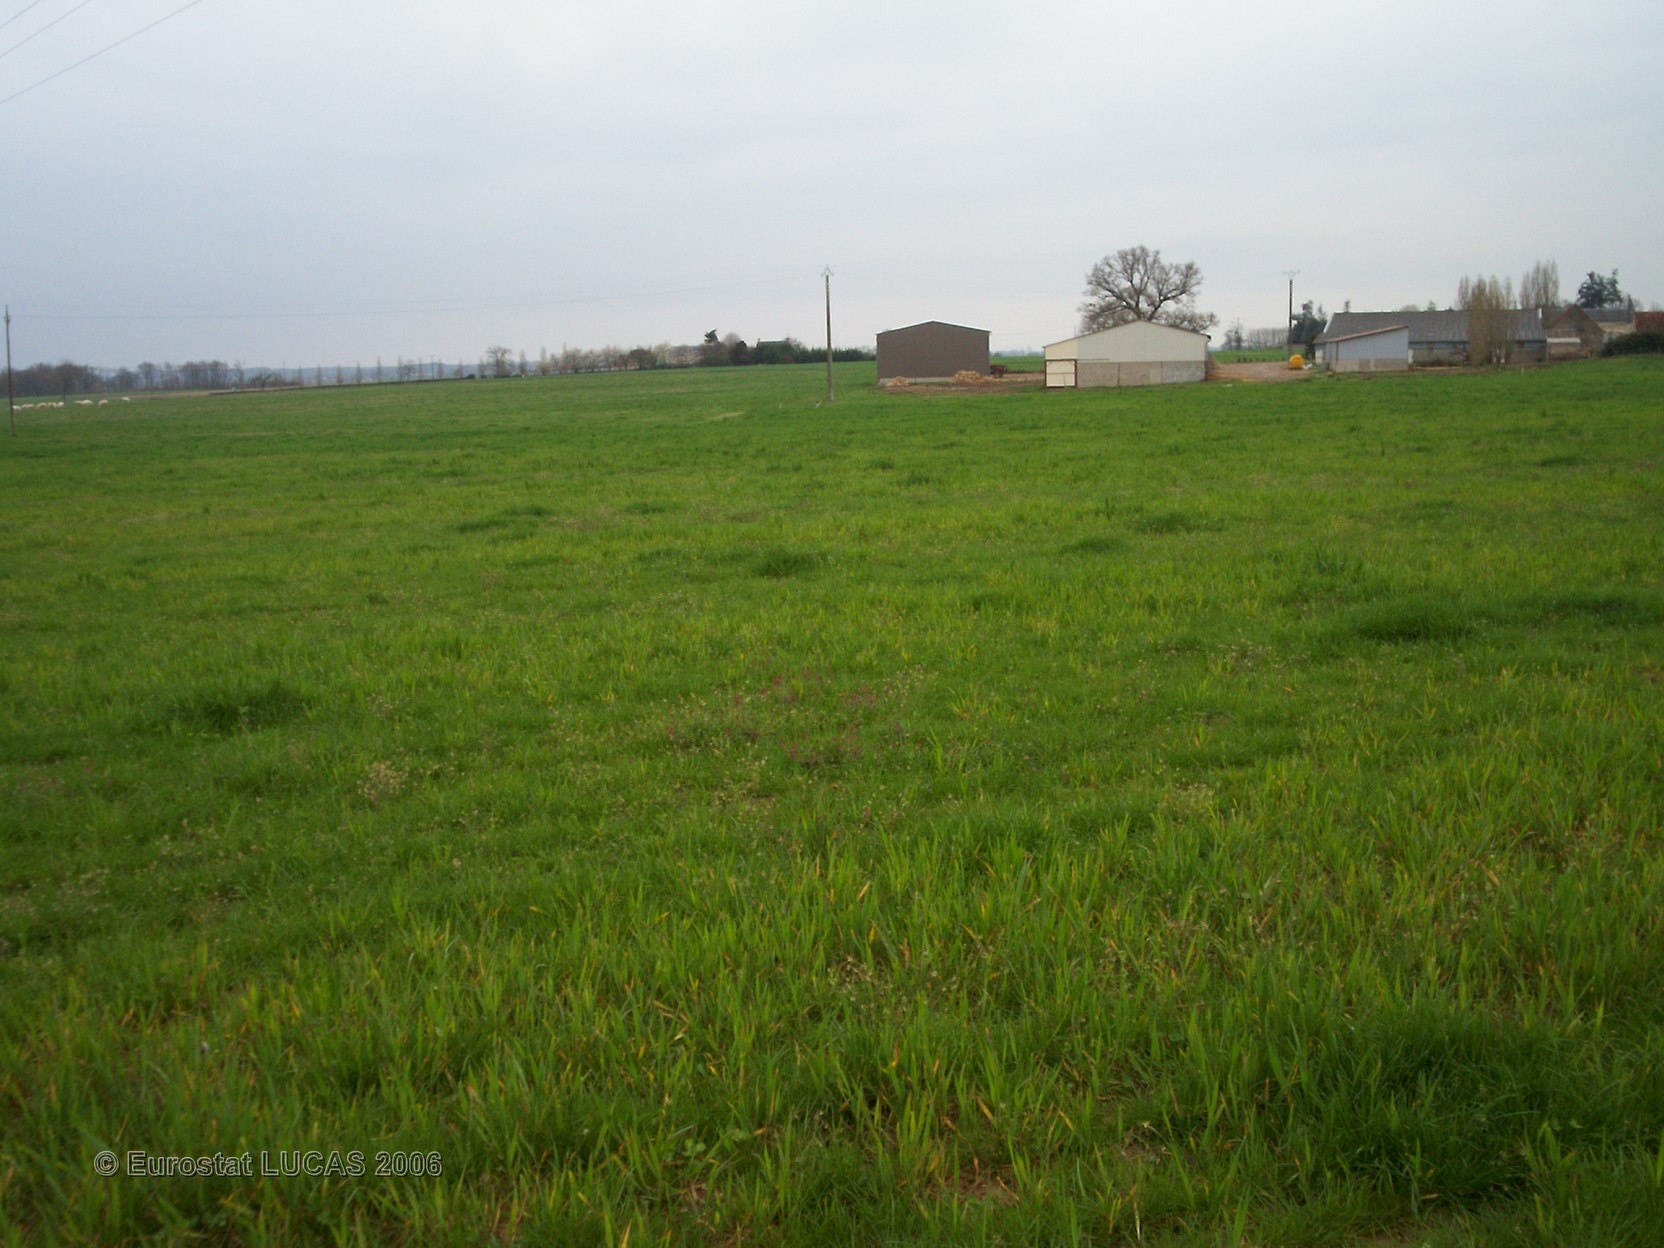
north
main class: Grassland
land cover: Grassland without tree/shrub cover
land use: Agriculture (excluding fallow land and kitchen gardens)
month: April
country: FR
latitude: 46.5731
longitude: 1.0487
